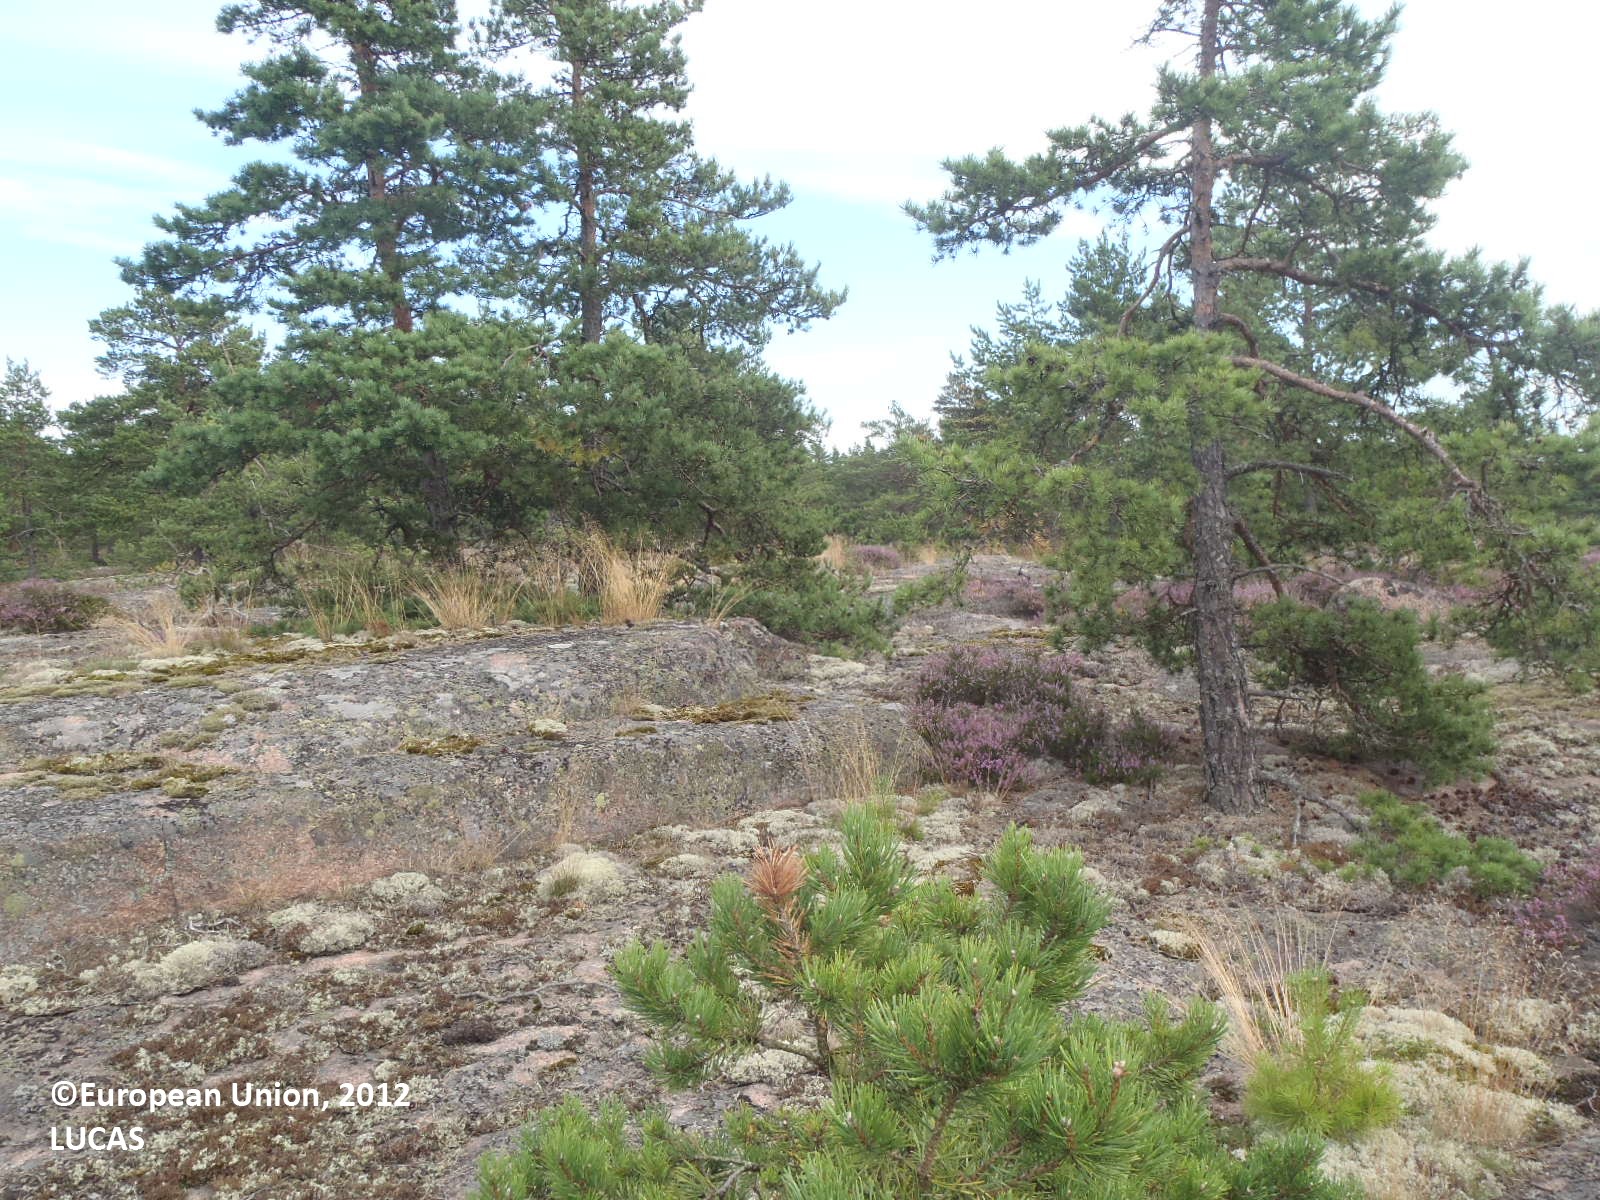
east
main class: Woodland
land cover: Pine dominated coniferous woodland
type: boreal forest
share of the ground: 10 - 25 %
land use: Semi-natural and natural areas not in use
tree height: > 5 m
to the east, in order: Pine dominated coniferous woodland
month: August
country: FI
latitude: 60.2321
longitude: 20.3928
